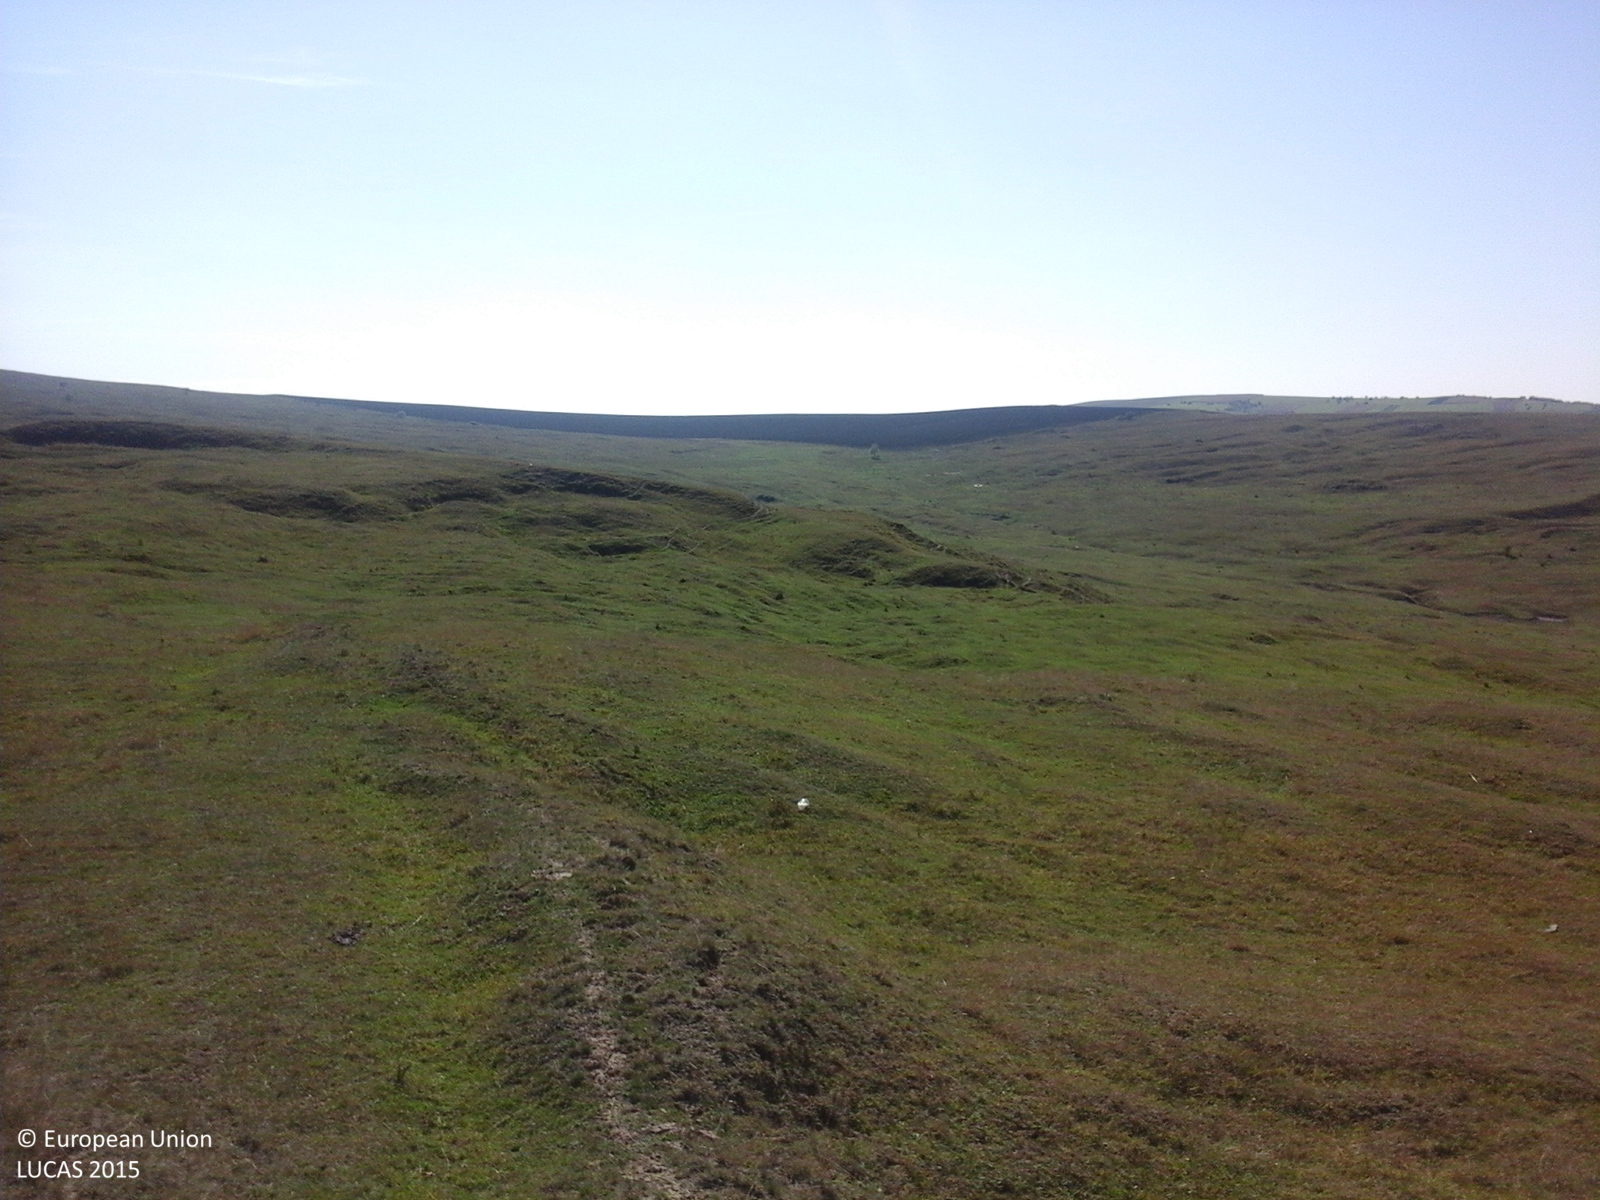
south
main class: Grassland
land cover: Grassland without tree/shrub cover
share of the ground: > 75 %
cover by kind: herbaceous plants 100 %
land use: Agriculture (excluding fallow land and kitchen gardens)
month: October
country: RO
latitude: 46.1623
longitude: 23.8114
